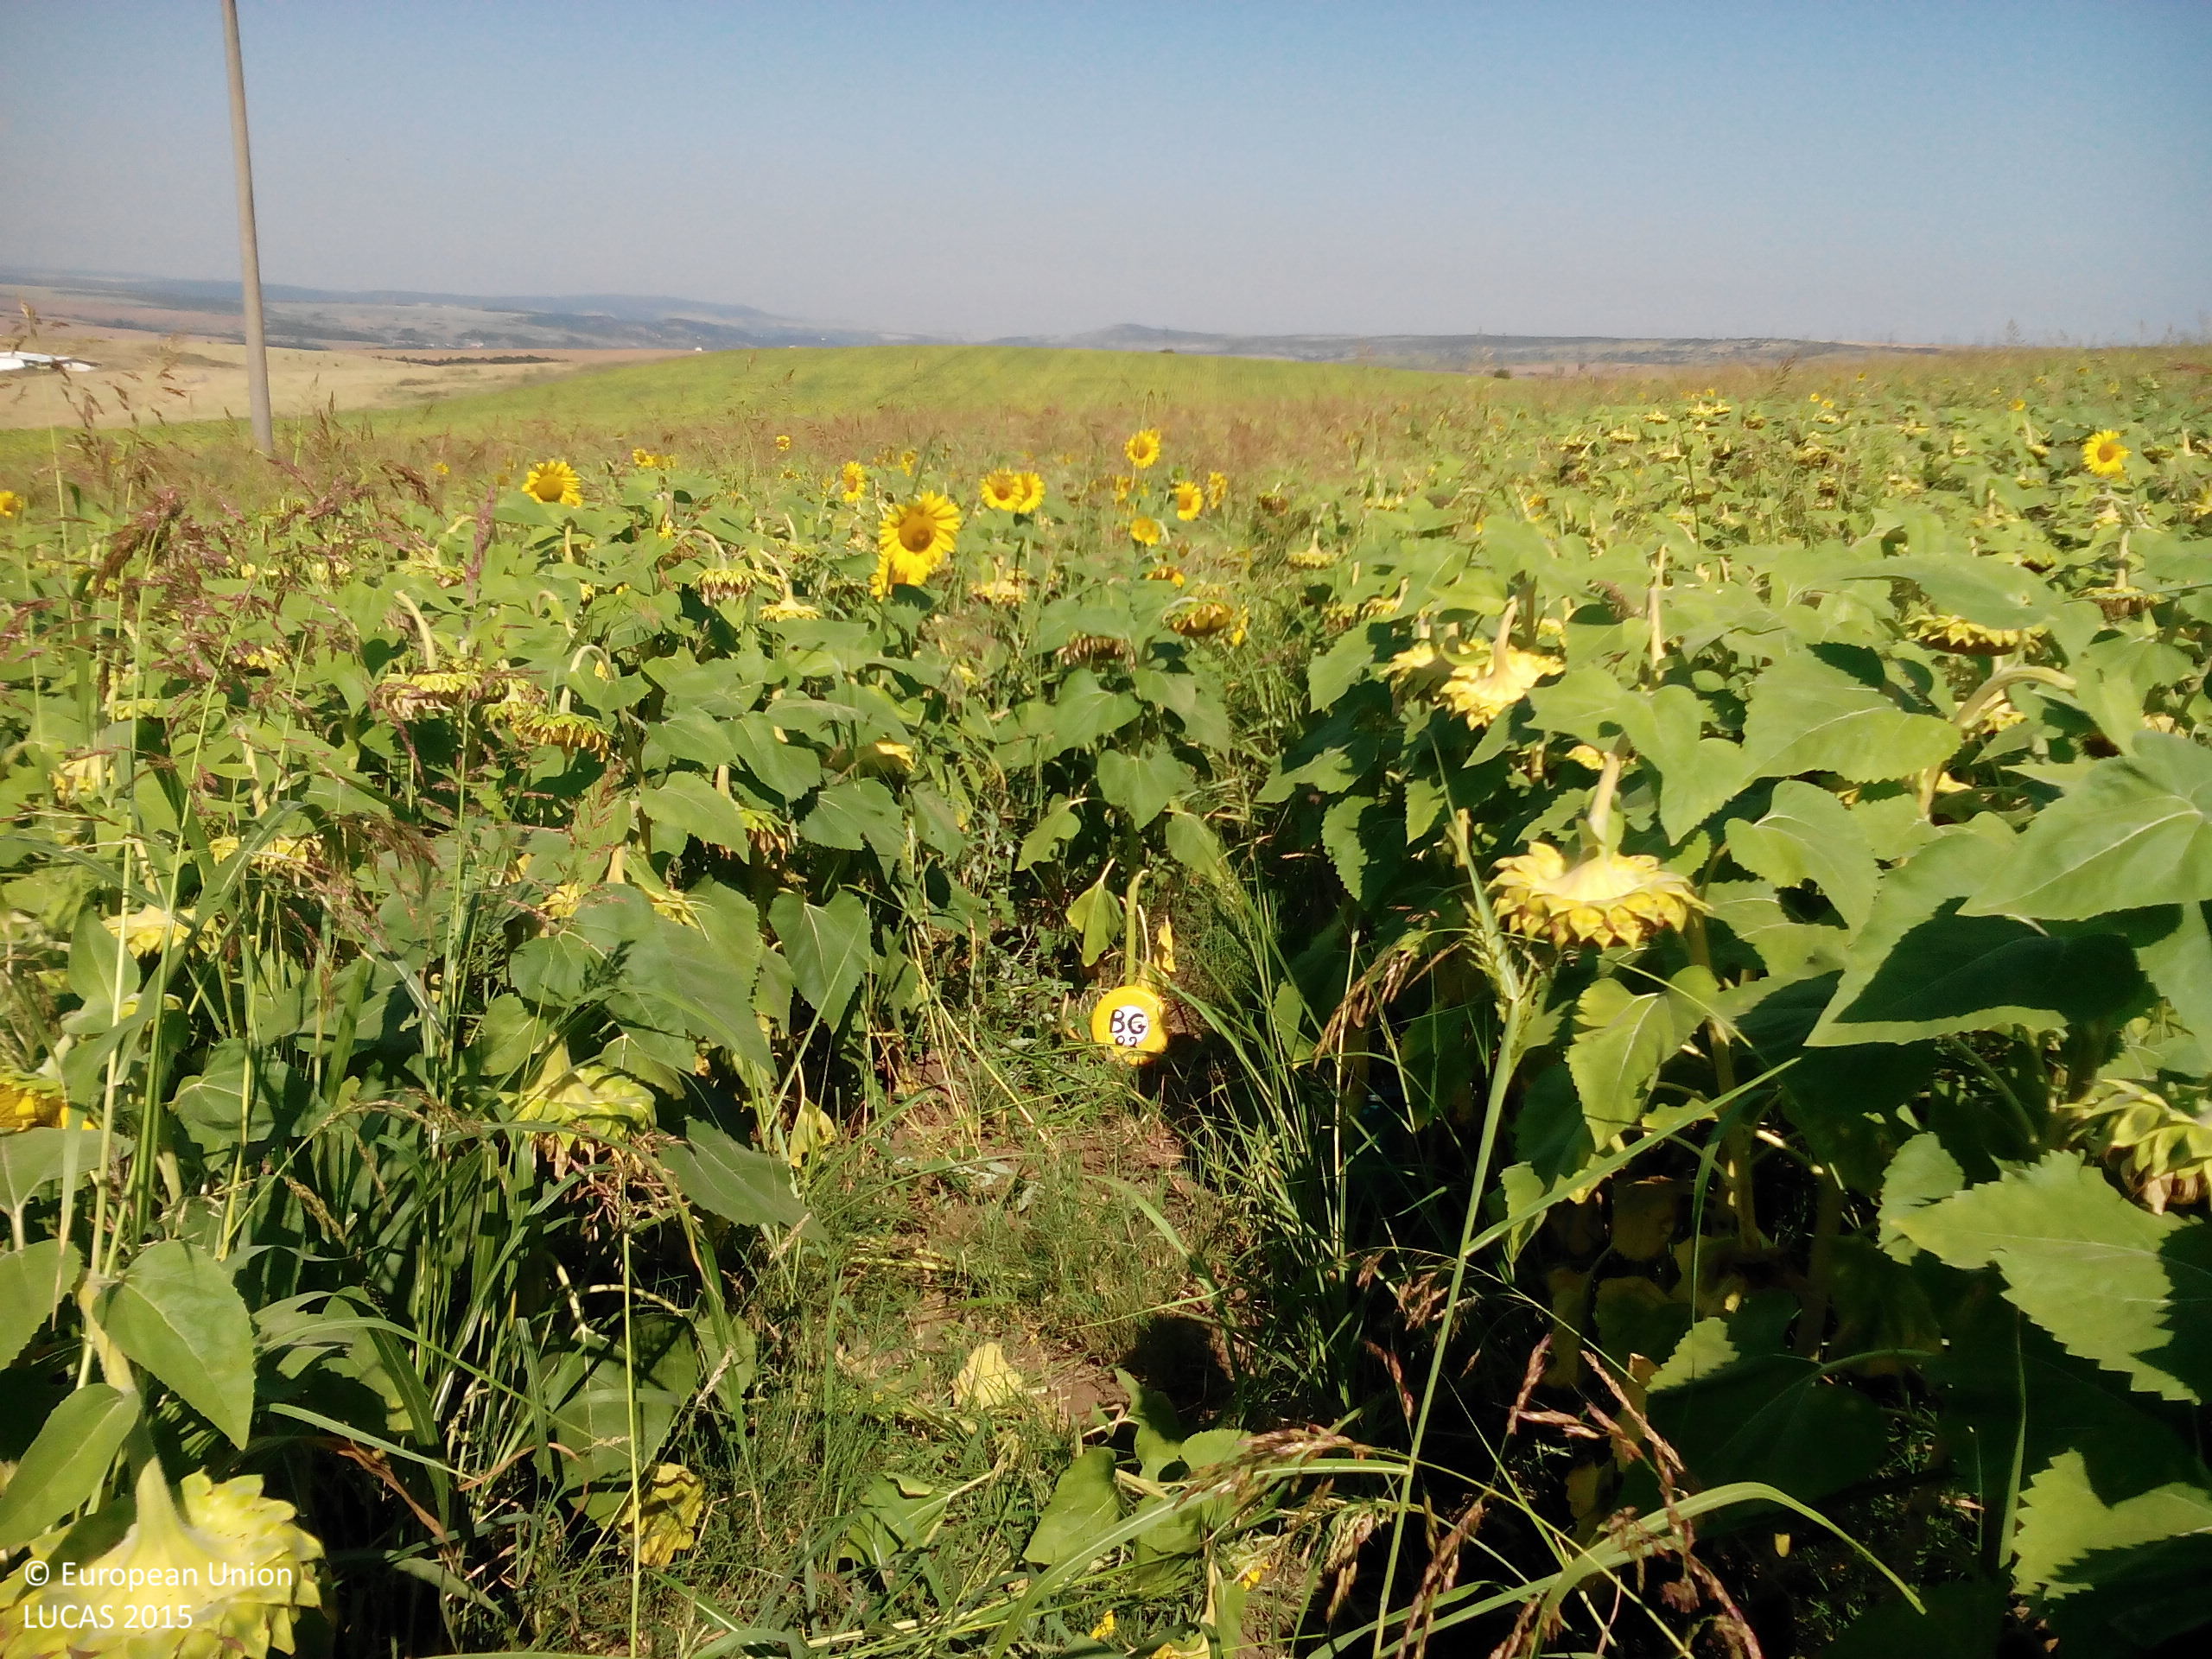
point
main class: Cropland
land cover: Sunflower
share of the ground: > 75 %
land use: Agriculture (excluding fallow land and kitchen gardens)
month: July
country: BG
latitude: 43.2574
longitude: 24.2077
